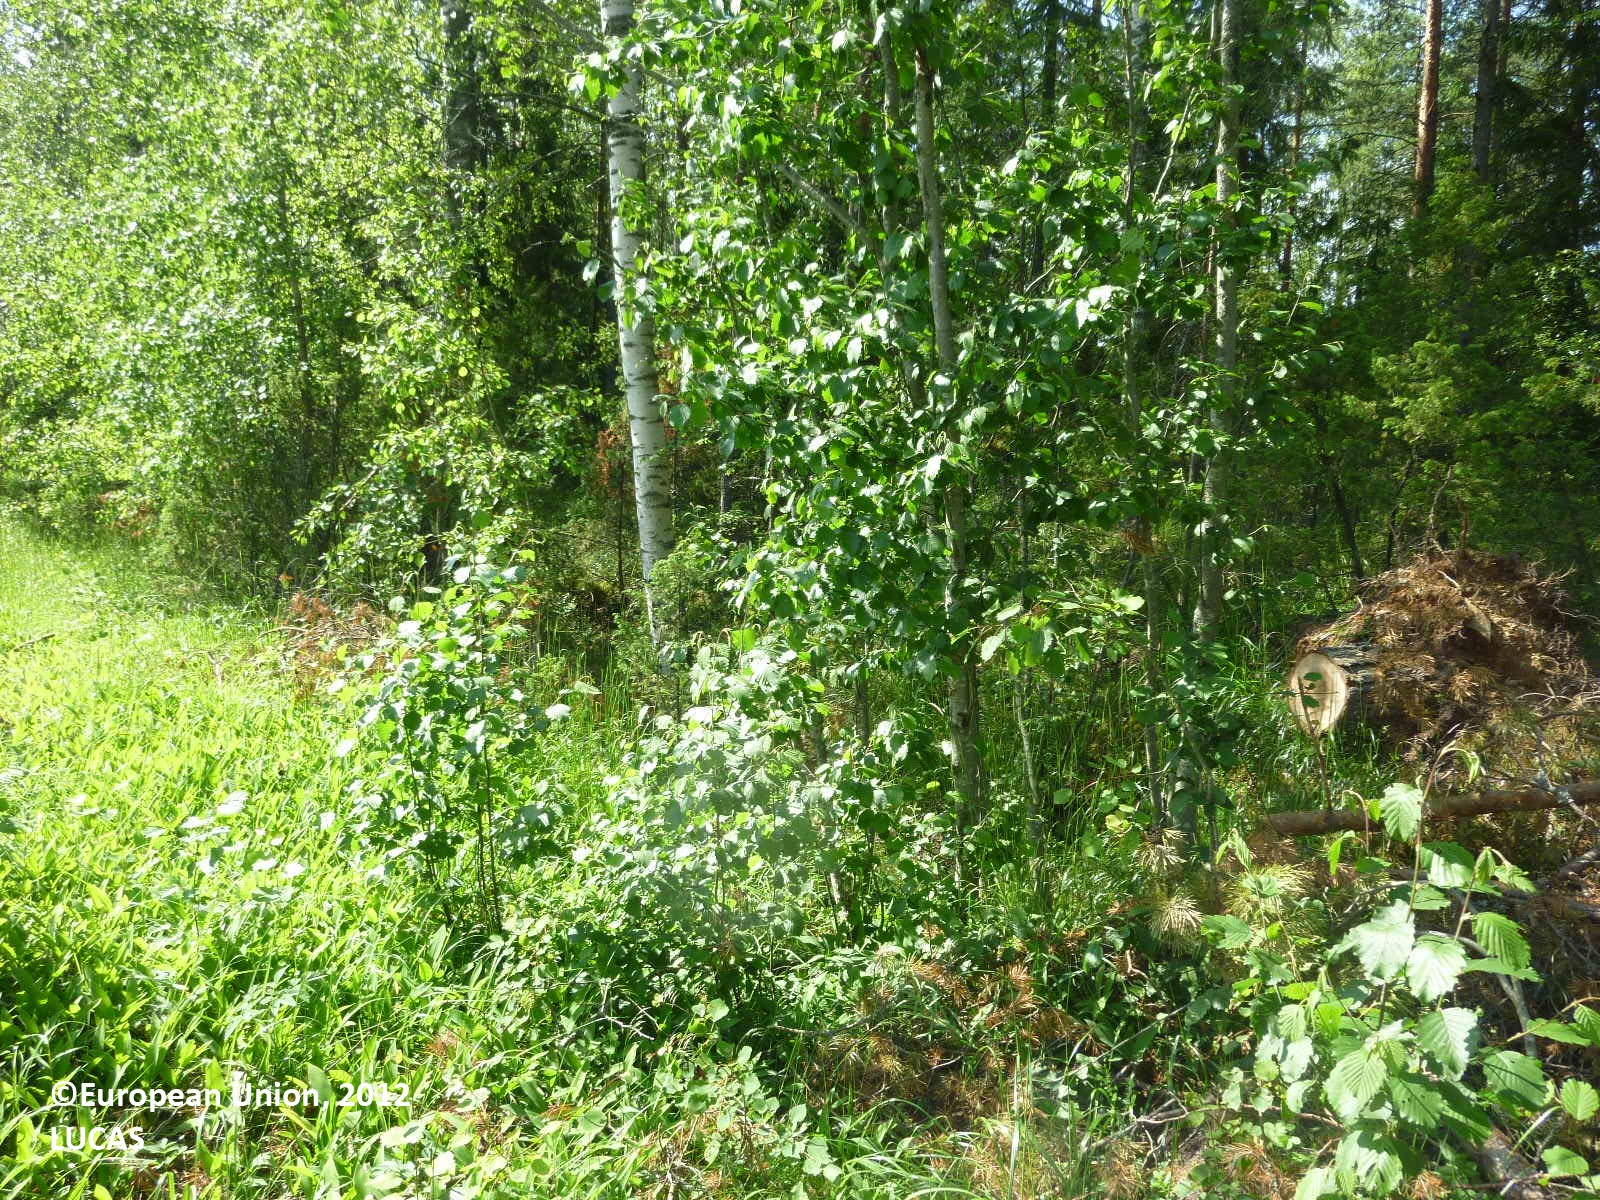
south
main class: Grassland
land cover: Grassland without tree/shrub cover
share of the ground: > 75 %
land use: Road transport
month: July
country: FI
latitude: 61.2545
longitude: 22.4225
